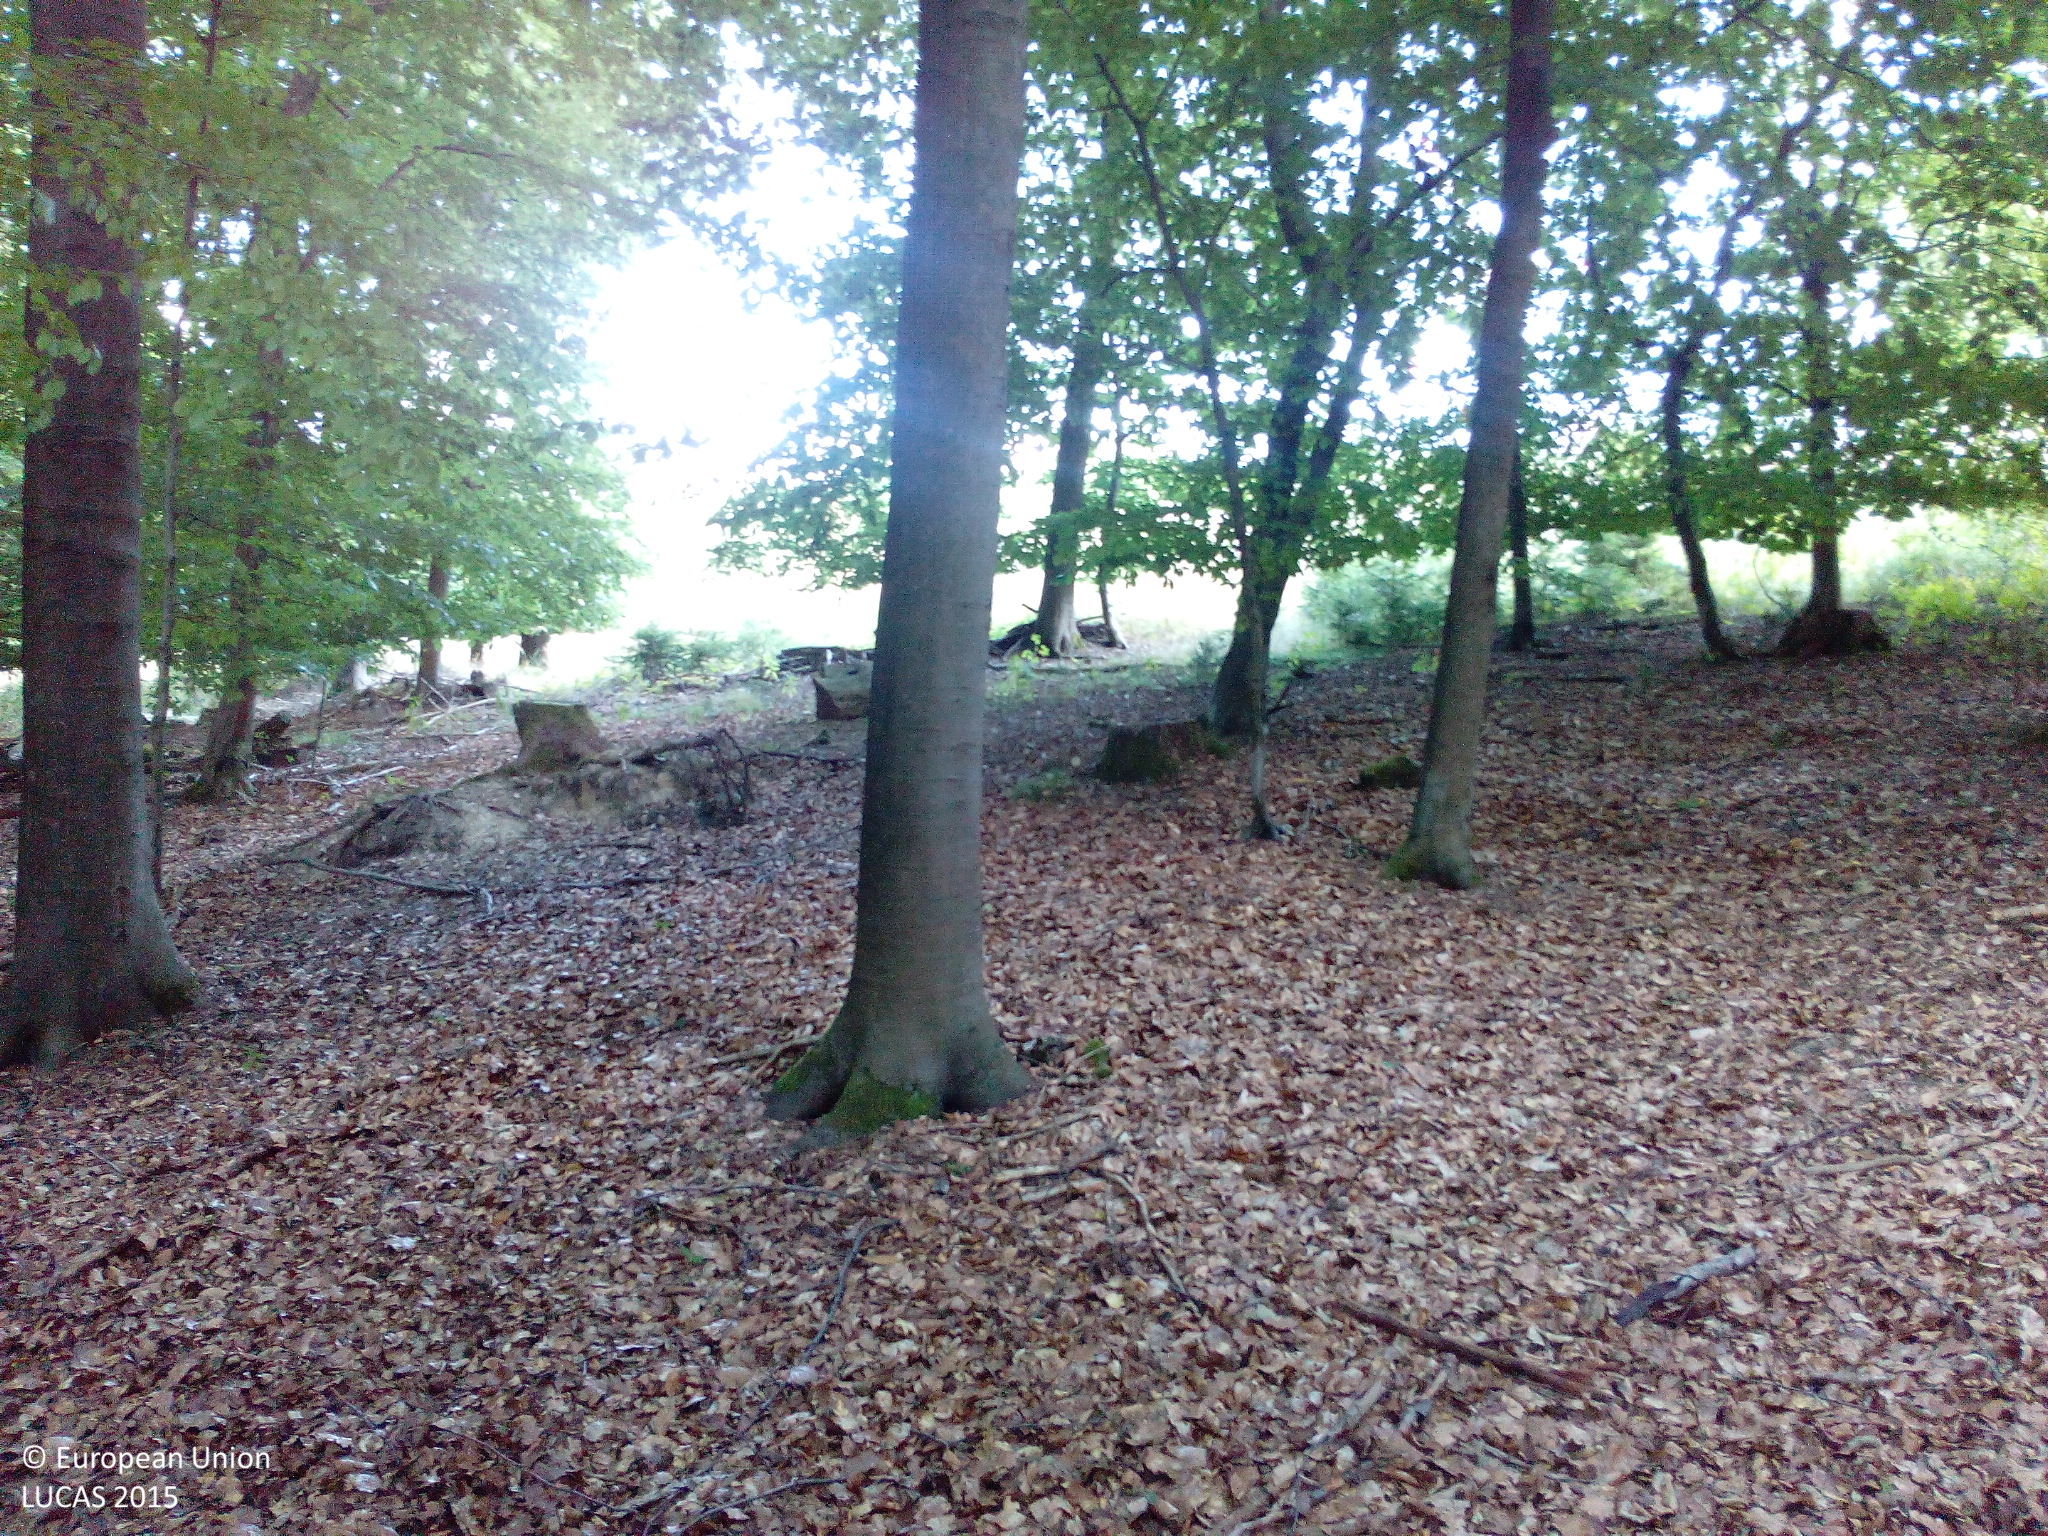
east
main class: Woodland
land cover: Broadleaved woodland
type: beech forest
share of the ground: > 75 %
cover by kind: broadleaved forest trees 90 %, unconsolidated bare surface 10 %
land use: Forestry
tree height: > 5 m
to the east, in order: Broadleaved woodland; Grassland without tree/shrub cover; Tracks; Grass margins; Lines of trees; Spruce dominated mixed woodland; Artificial constructions; Spruce dominated mixed woodland
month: August
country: DE
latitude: 50.1034
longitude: 7.5256
